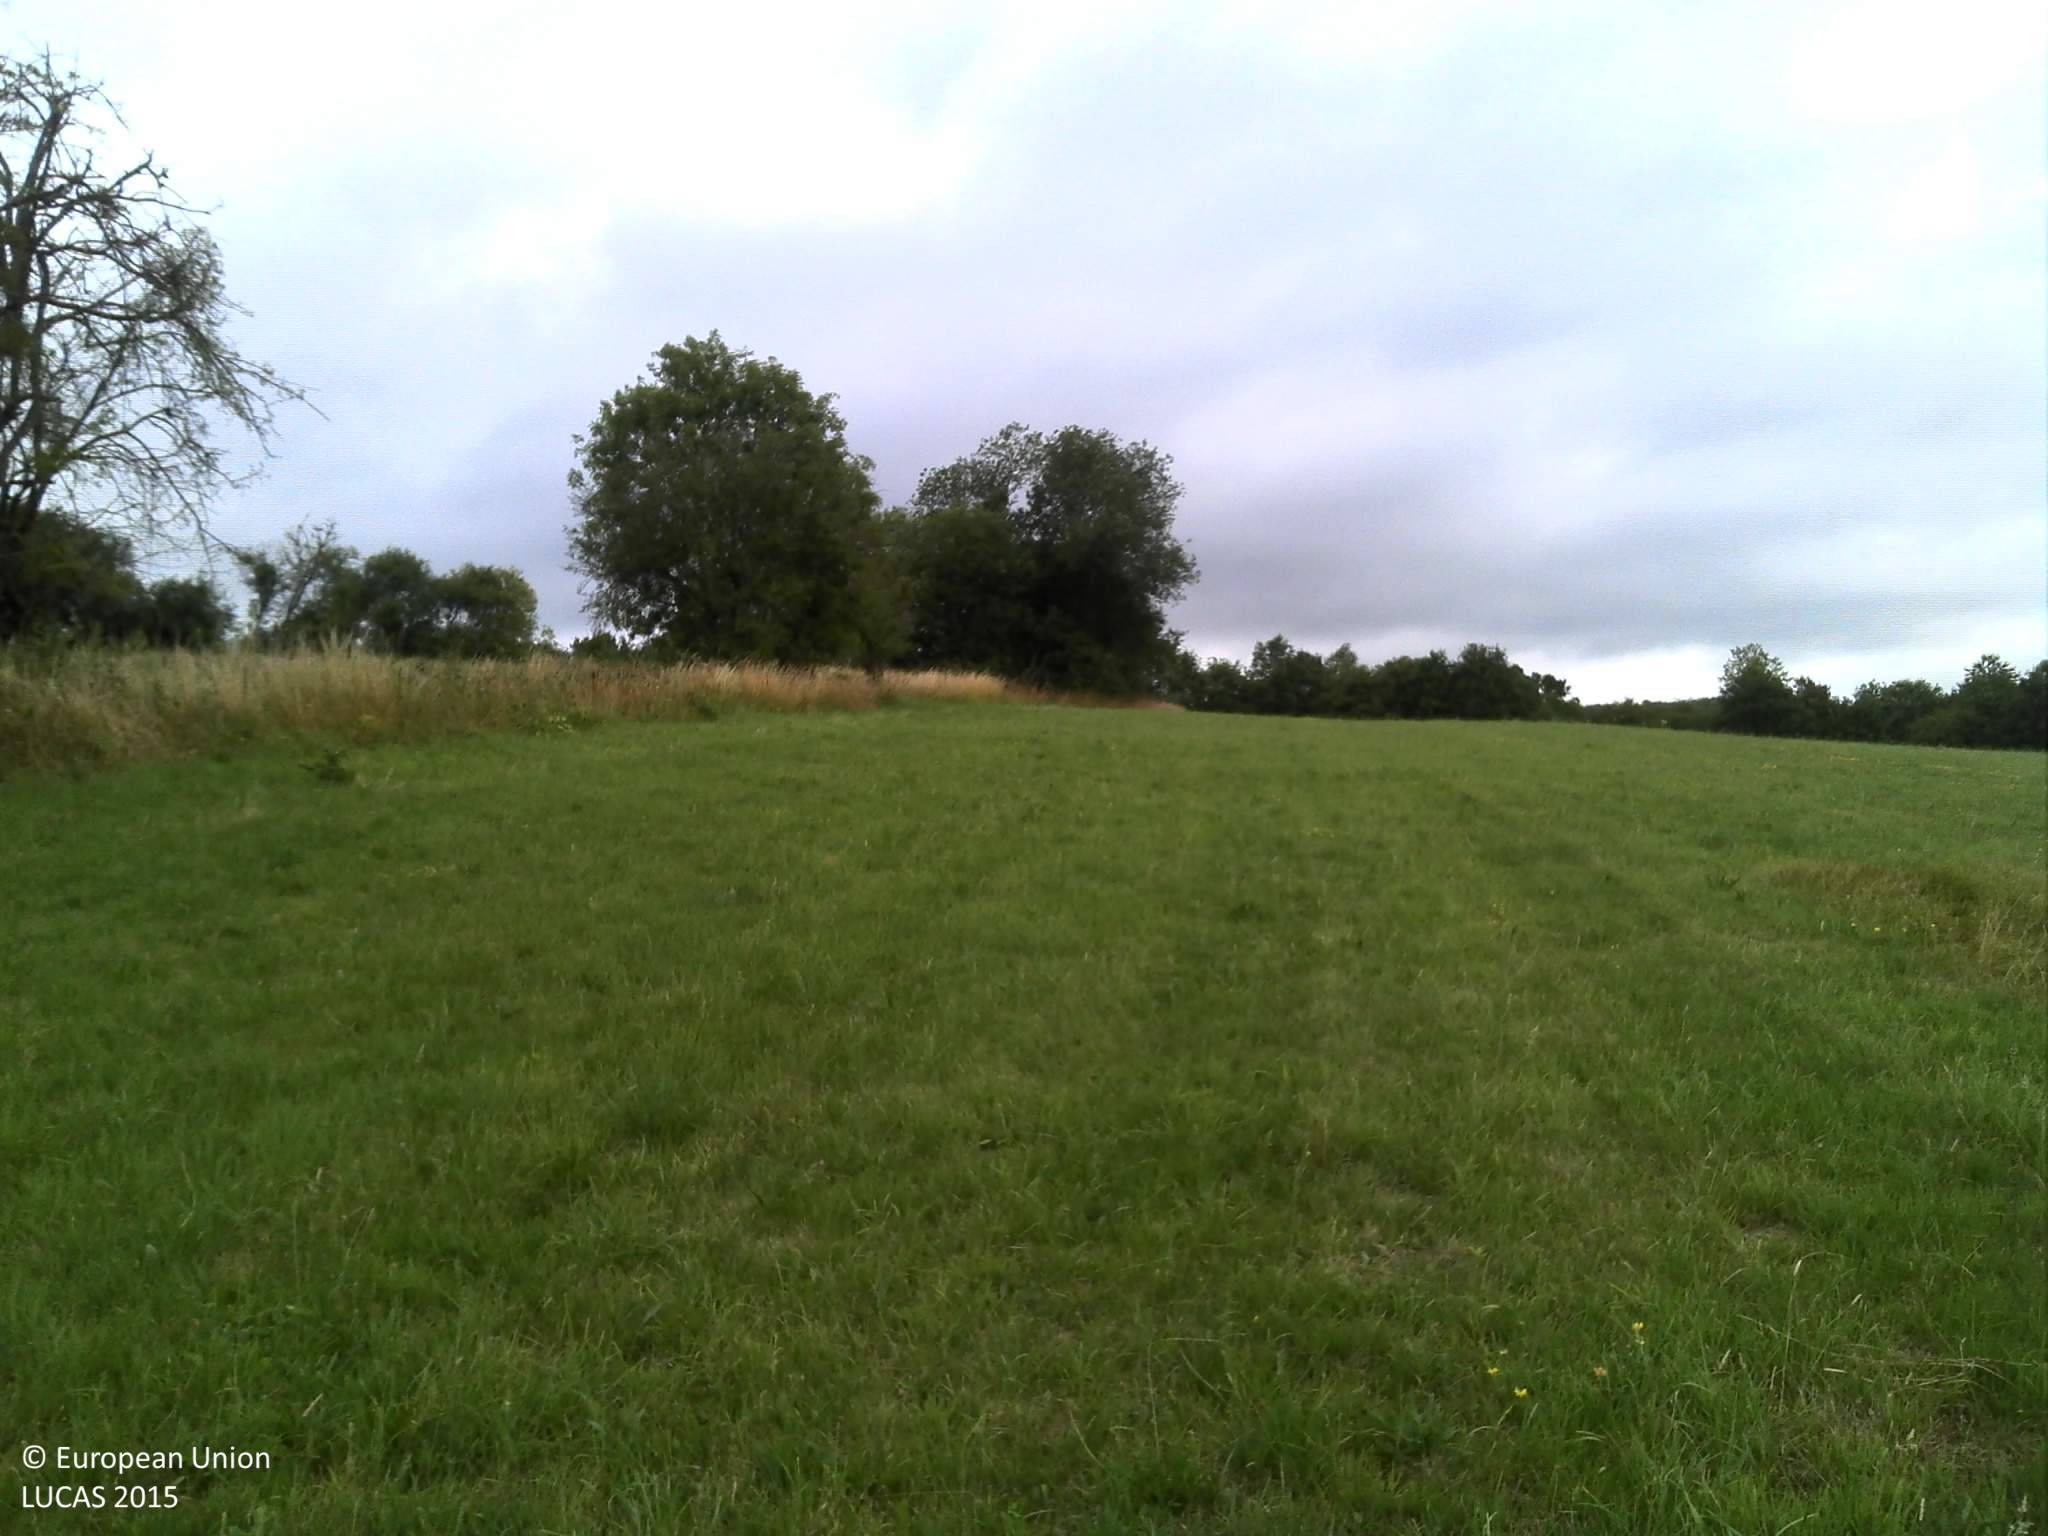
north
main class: Grassland
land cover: Grassland without tree/shrub cover
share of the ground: > 75 %
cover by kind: herbaceous plants 100 %
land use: Agriculture (excluding fallow land and kitchen gardens)
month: July
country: FR
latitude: 49.7909
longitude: 4.7043
